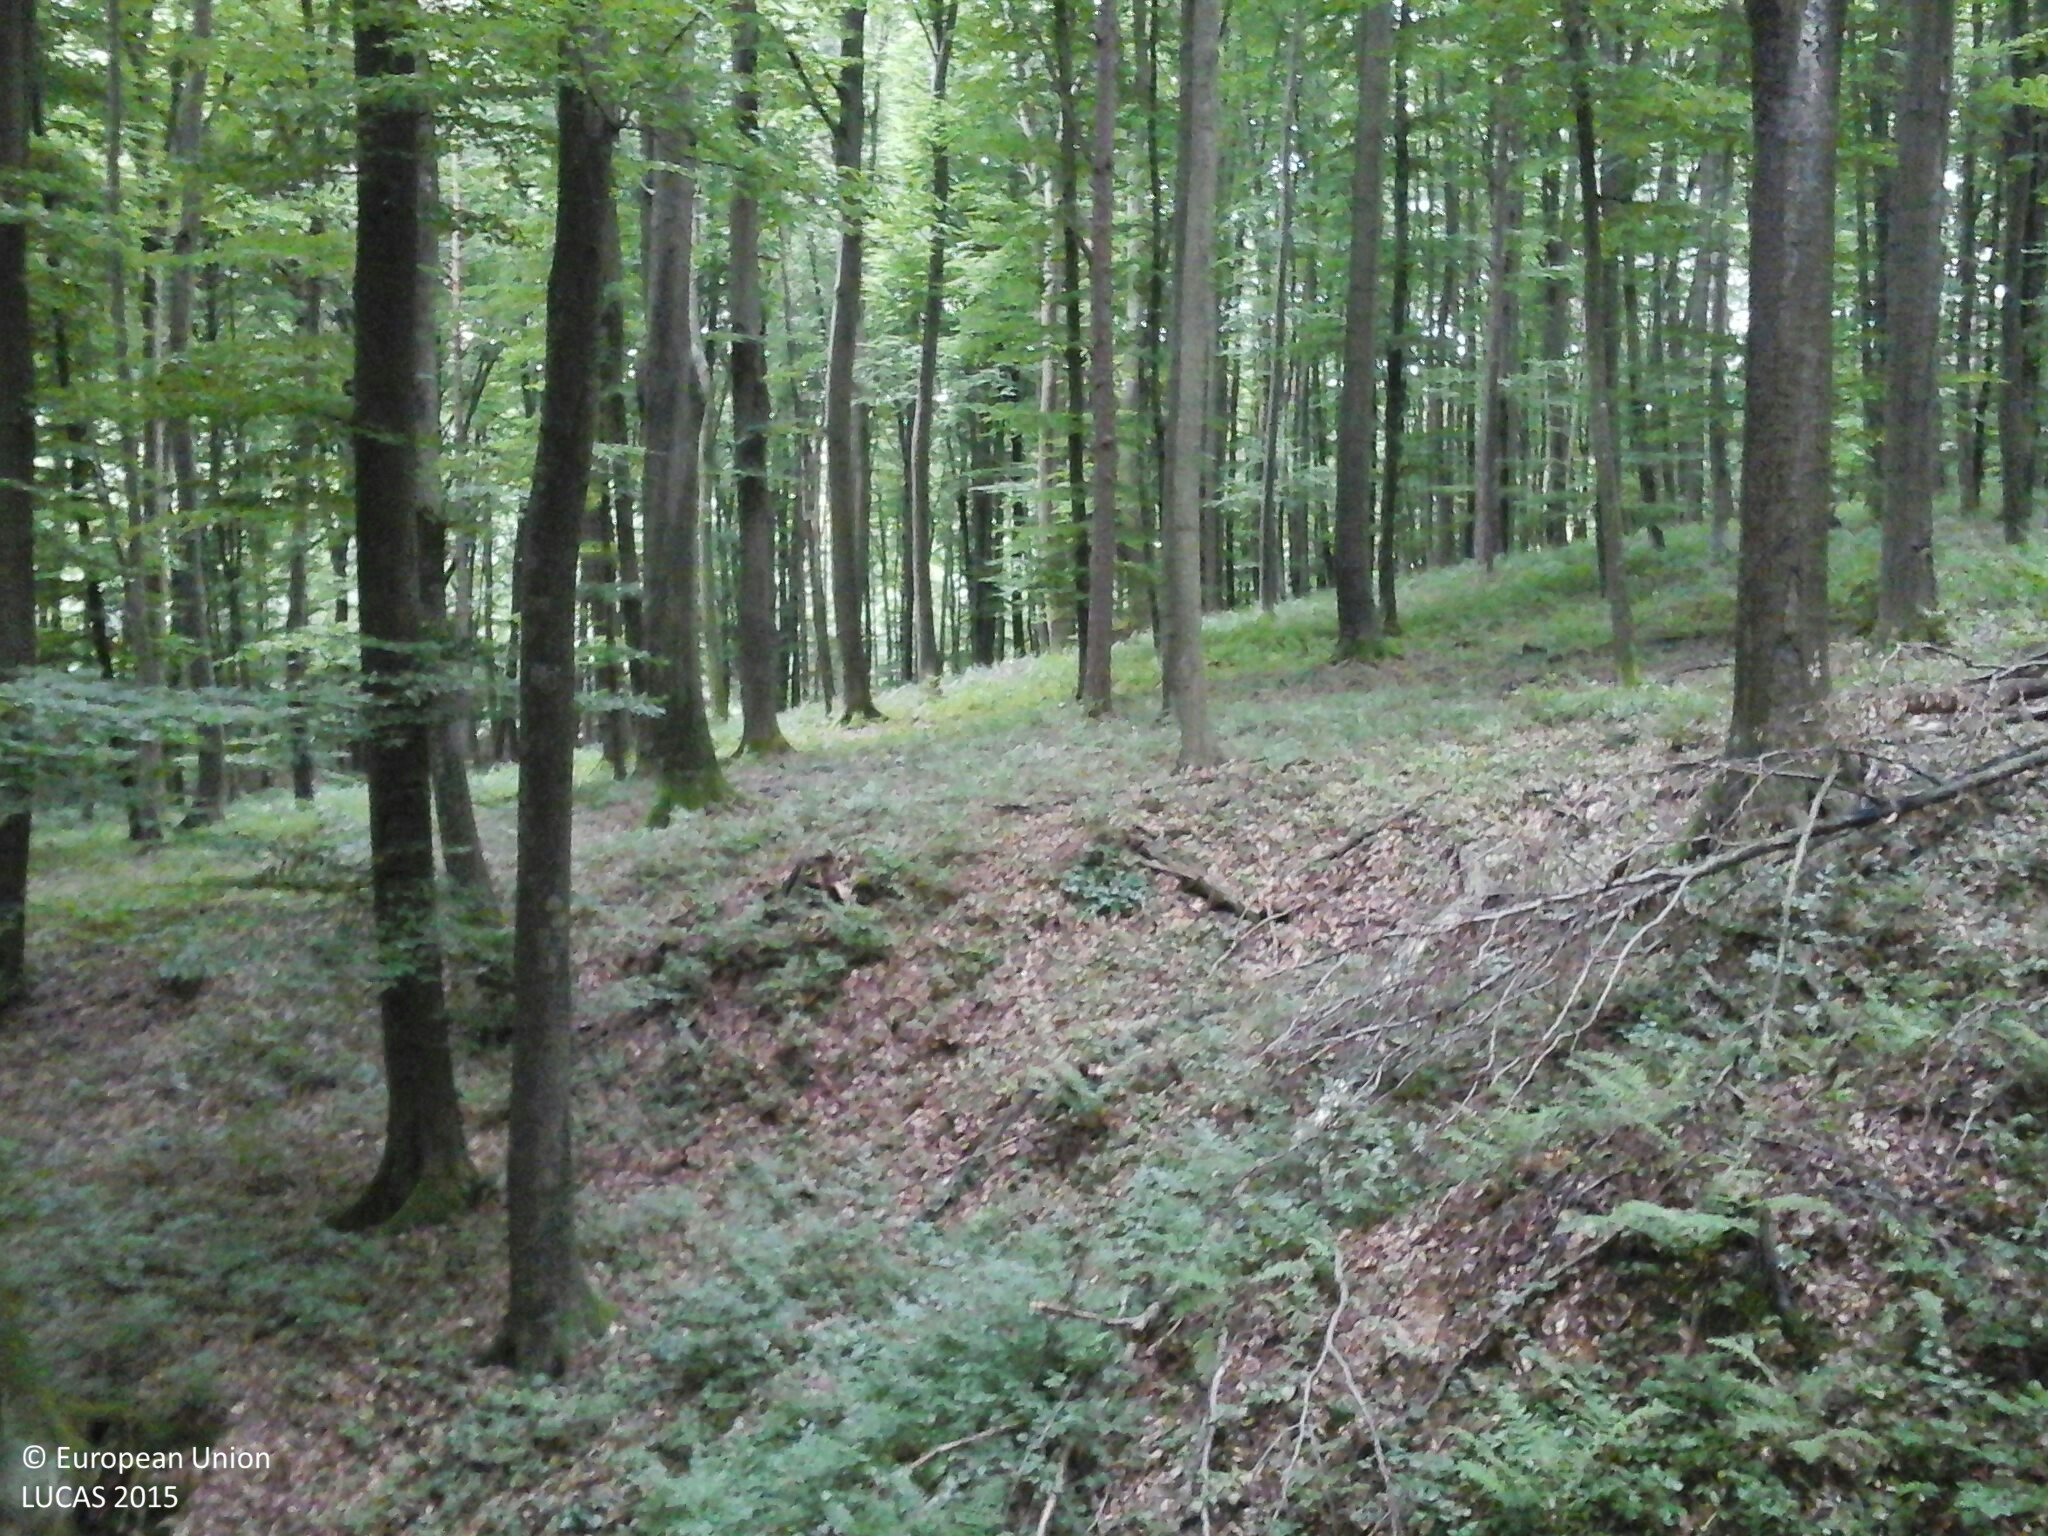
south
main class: Woodland
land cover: Broadleaved woodland
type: beech forest
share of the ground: > 75 %
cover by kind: broadleaved forest trees 95 %, shrubs 5 %
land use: Forestry
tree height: > 5 m
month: July
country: HU
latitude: 46.8161
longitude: 16.5948
